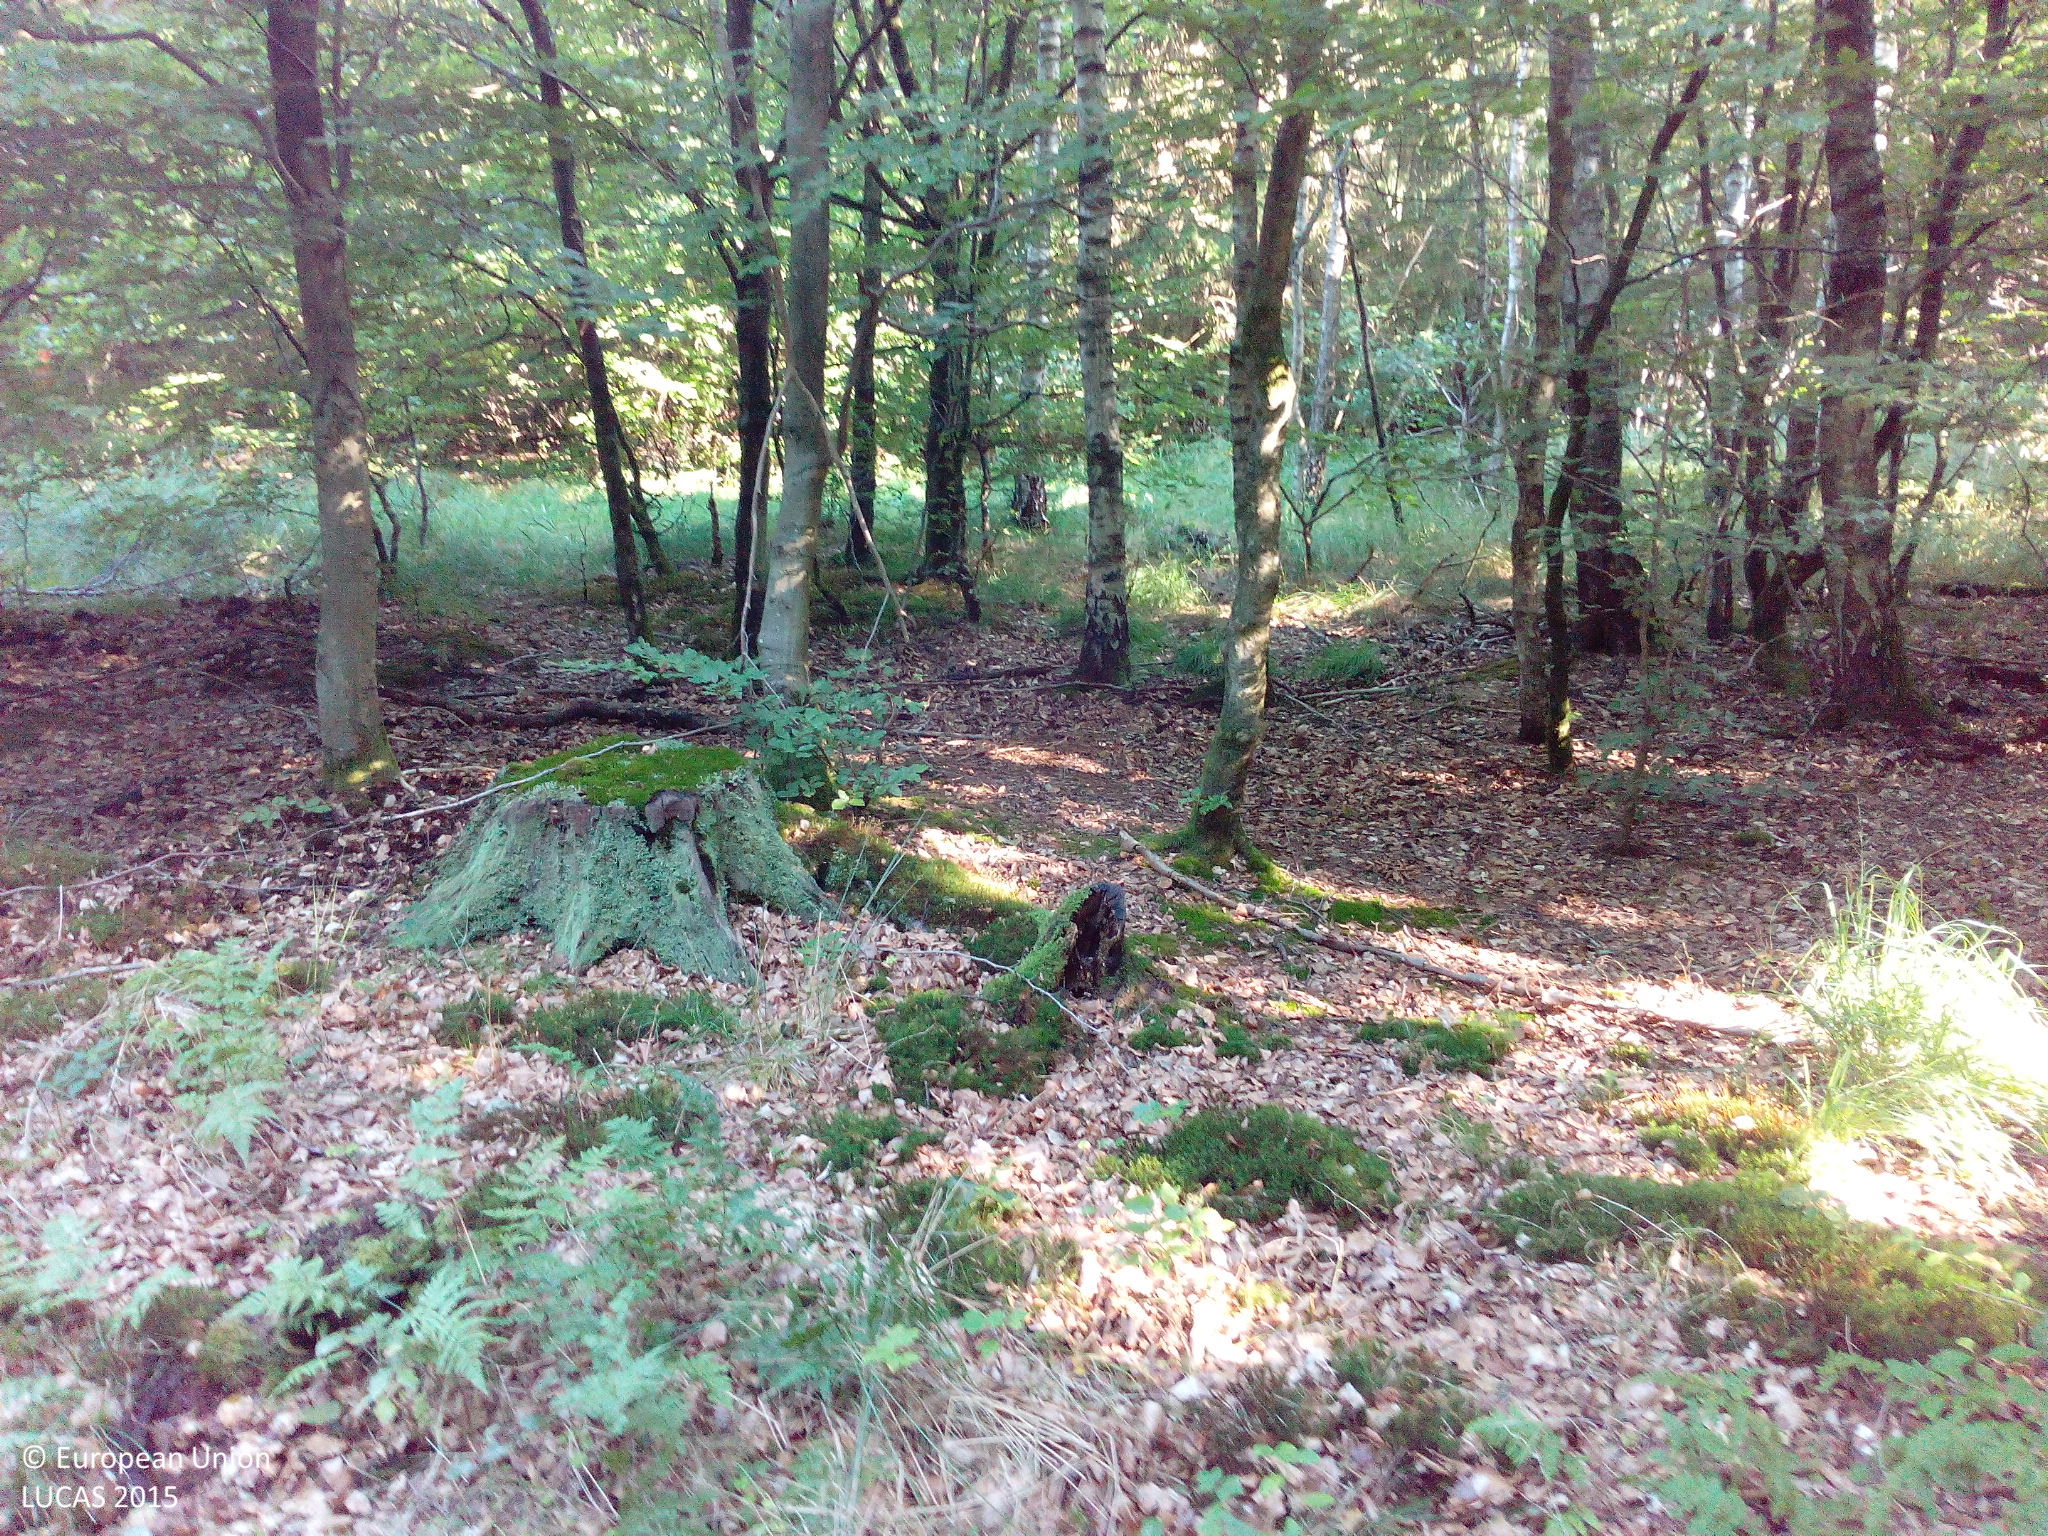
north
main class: Woodland
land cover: Broadleaved woodland
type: beech forest
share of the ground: > 75 %
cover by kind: broadleaved forest trees 85 %, herbaceous plants 10 %, shrubs 5 %
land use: Forestry
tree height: > 5 m
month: September
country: DE
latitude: 54.2064
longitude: 12.3447
